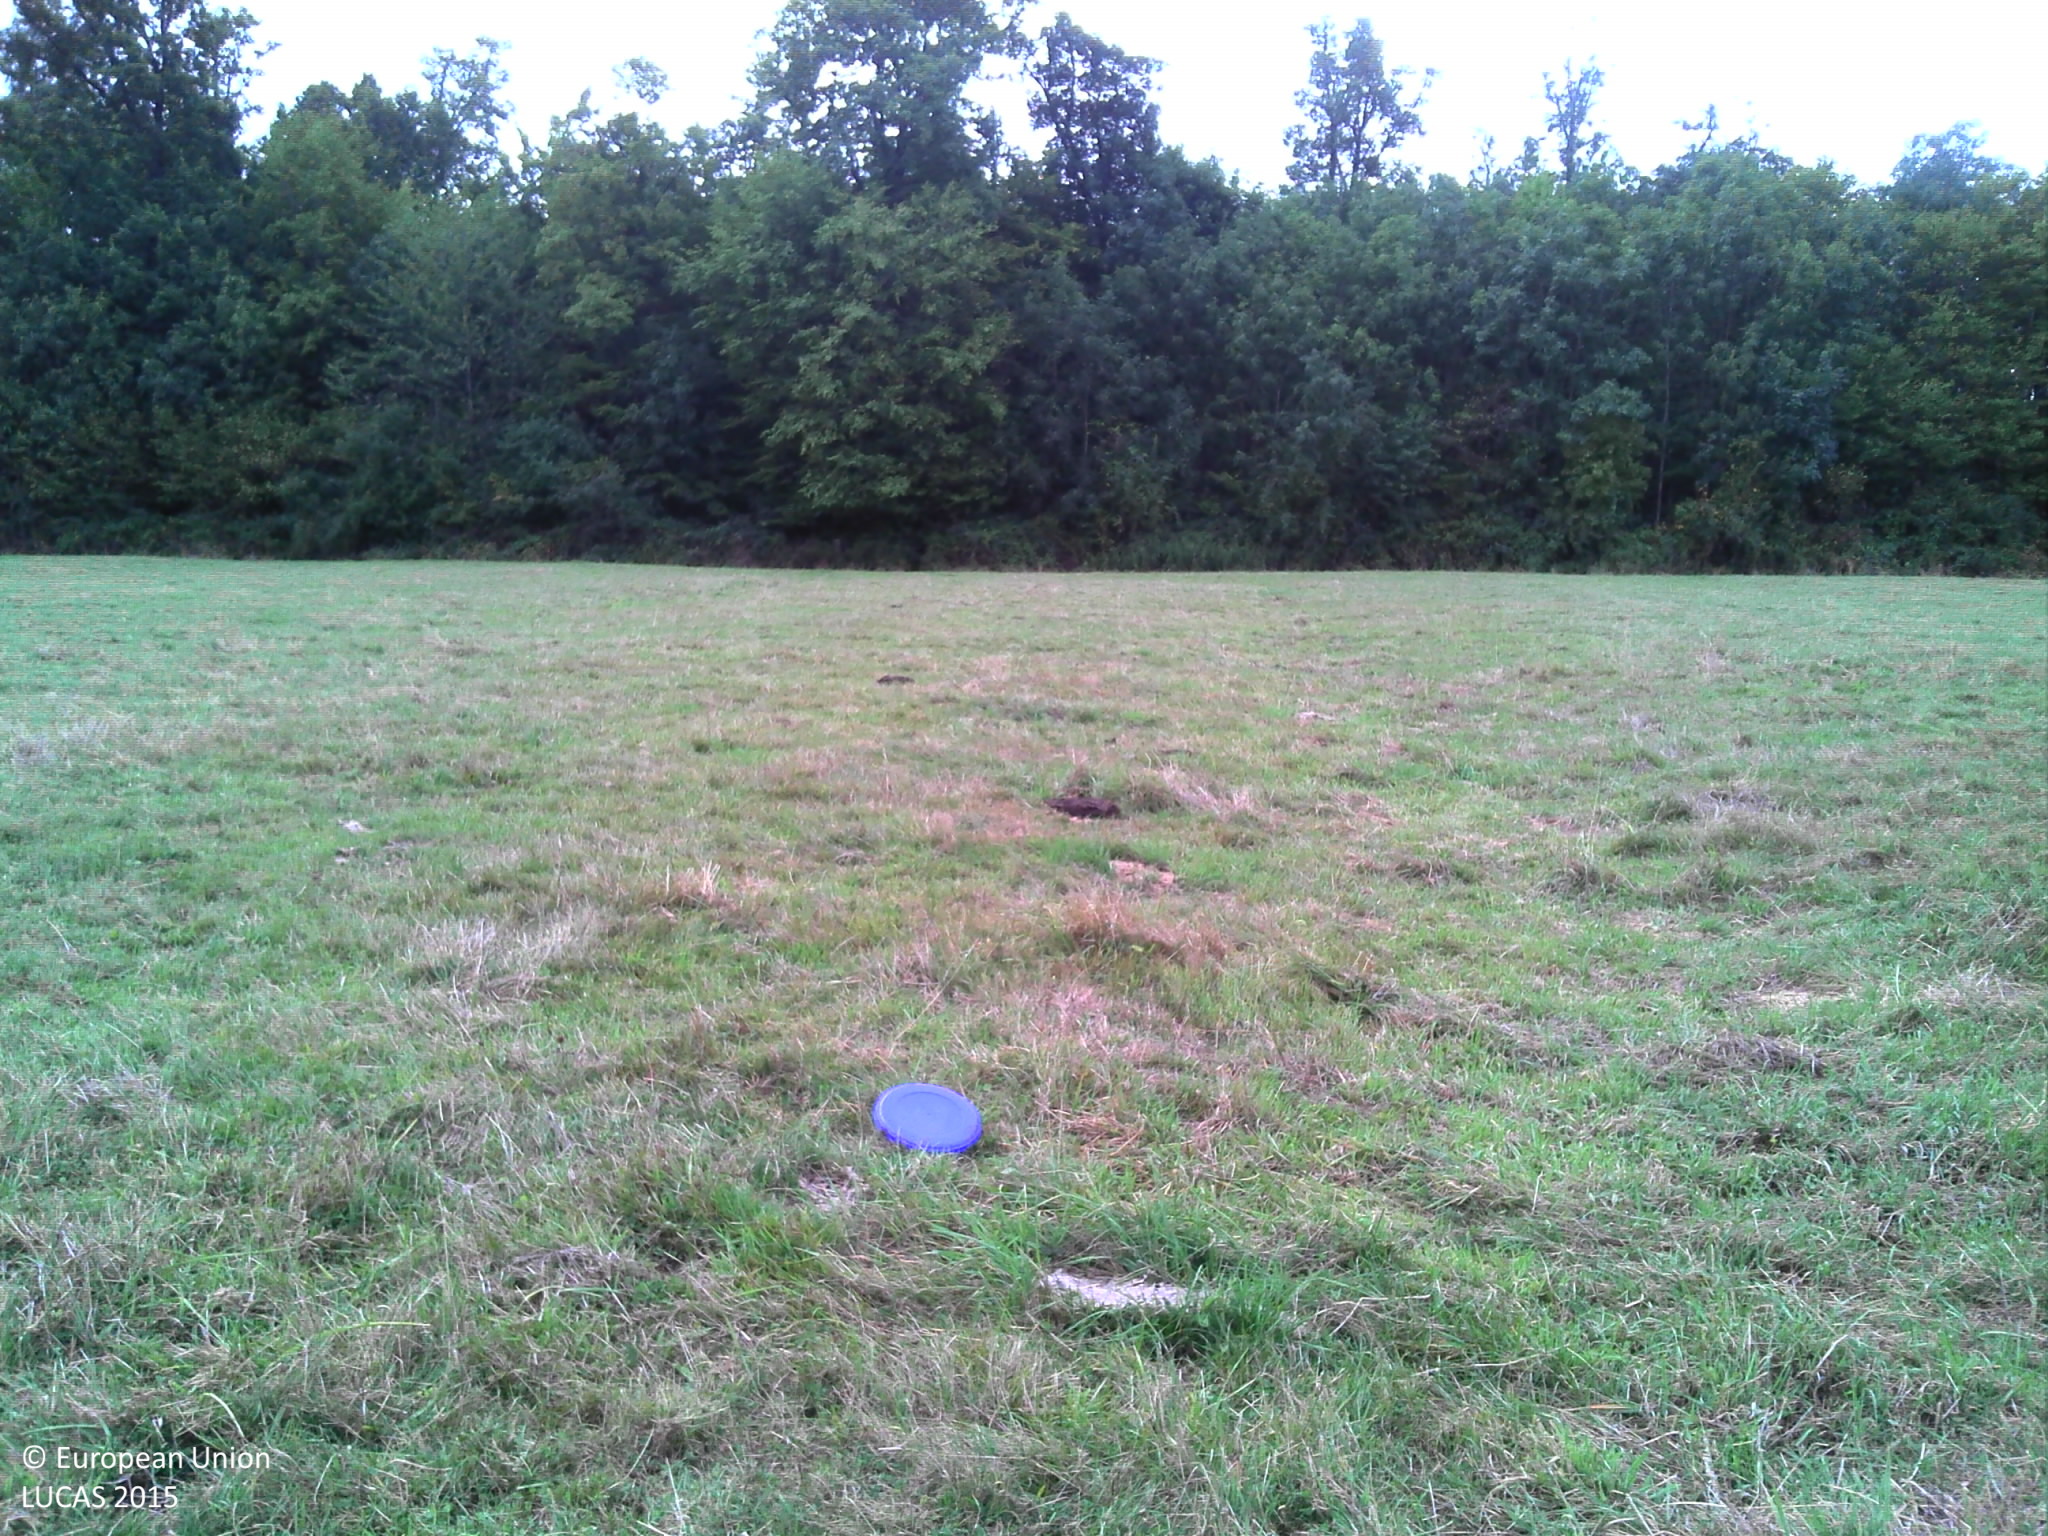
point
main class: Grassland
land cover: Grassland without tree/shrub cover
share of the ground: > 75 %
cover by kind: herbaceous plants 95 %, consolidated bare surface 5 %
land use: Agriculture (excluding fallow land and kitchen gardens)
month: September
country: FR
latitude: 48.5532
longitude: 6.1661
